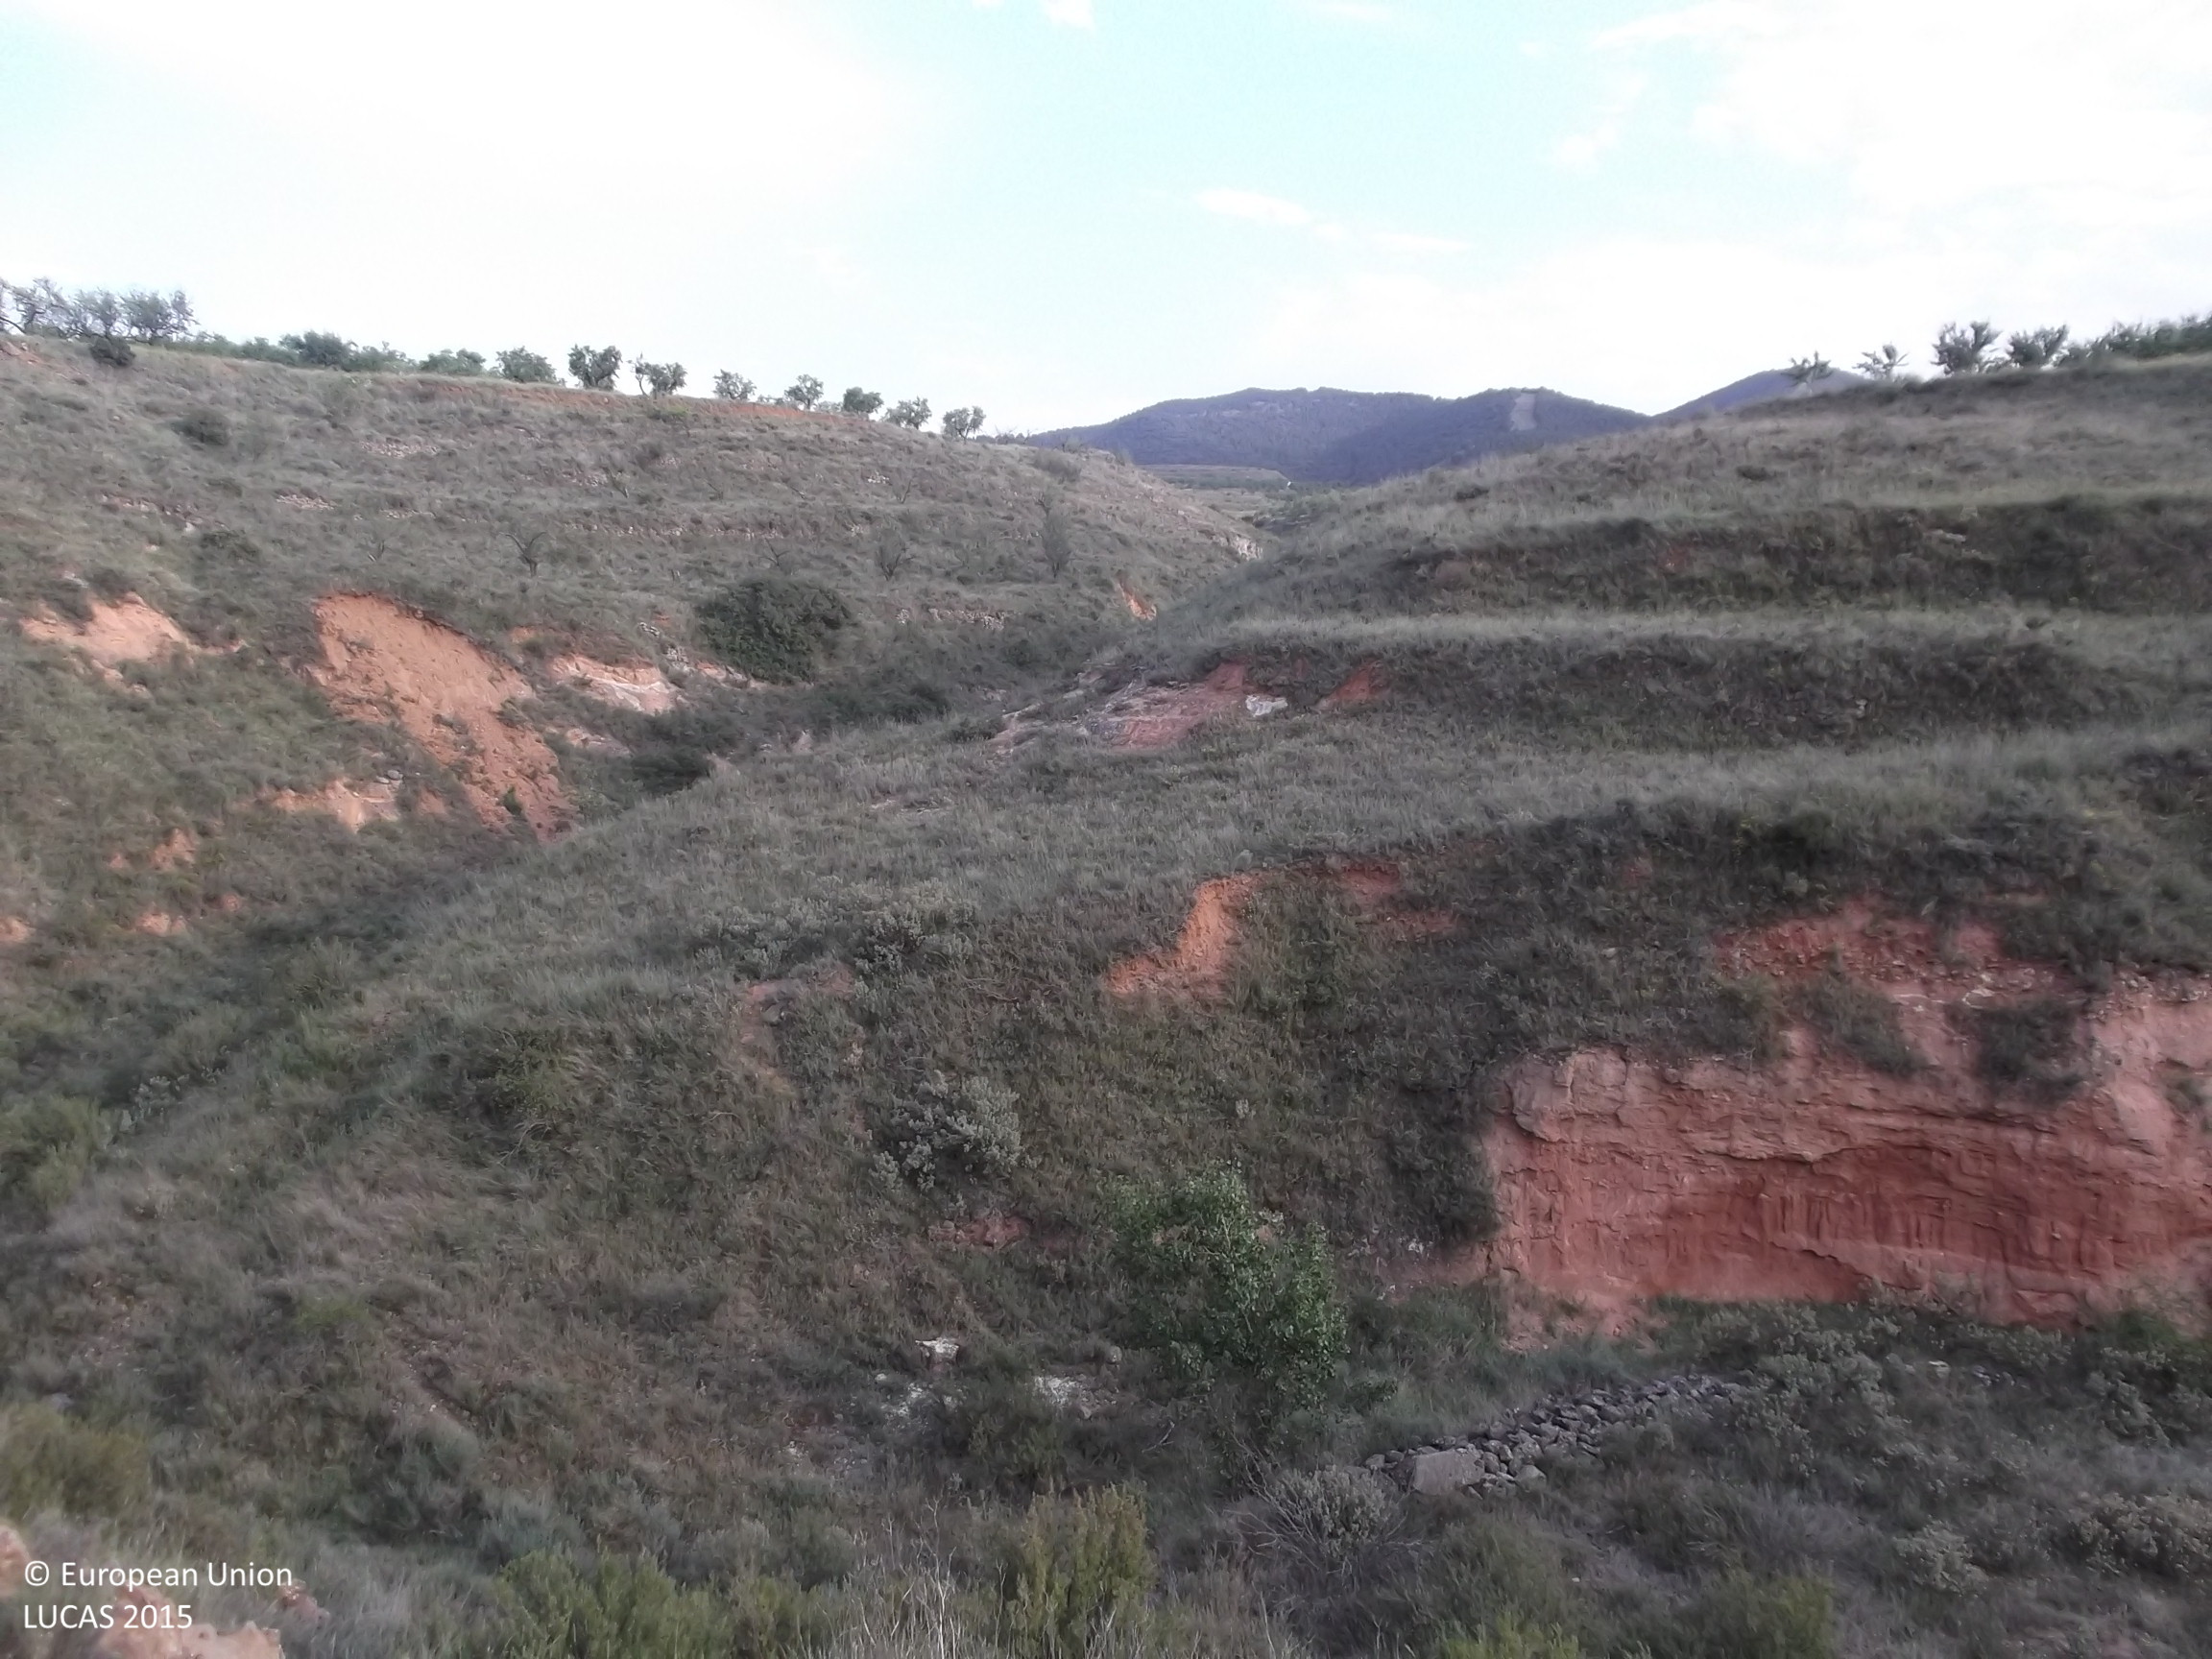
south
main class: Shrubland
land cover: Shrubland without tree cover
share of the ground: 50 - 75 %
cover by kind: shrubs 50 %, herbaceous plants 30 %, unconsolidated bare surface 20 %
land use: Semi-natural and natural areas not in use
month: July
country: ES
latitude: 42.1830
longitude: -2.0849
